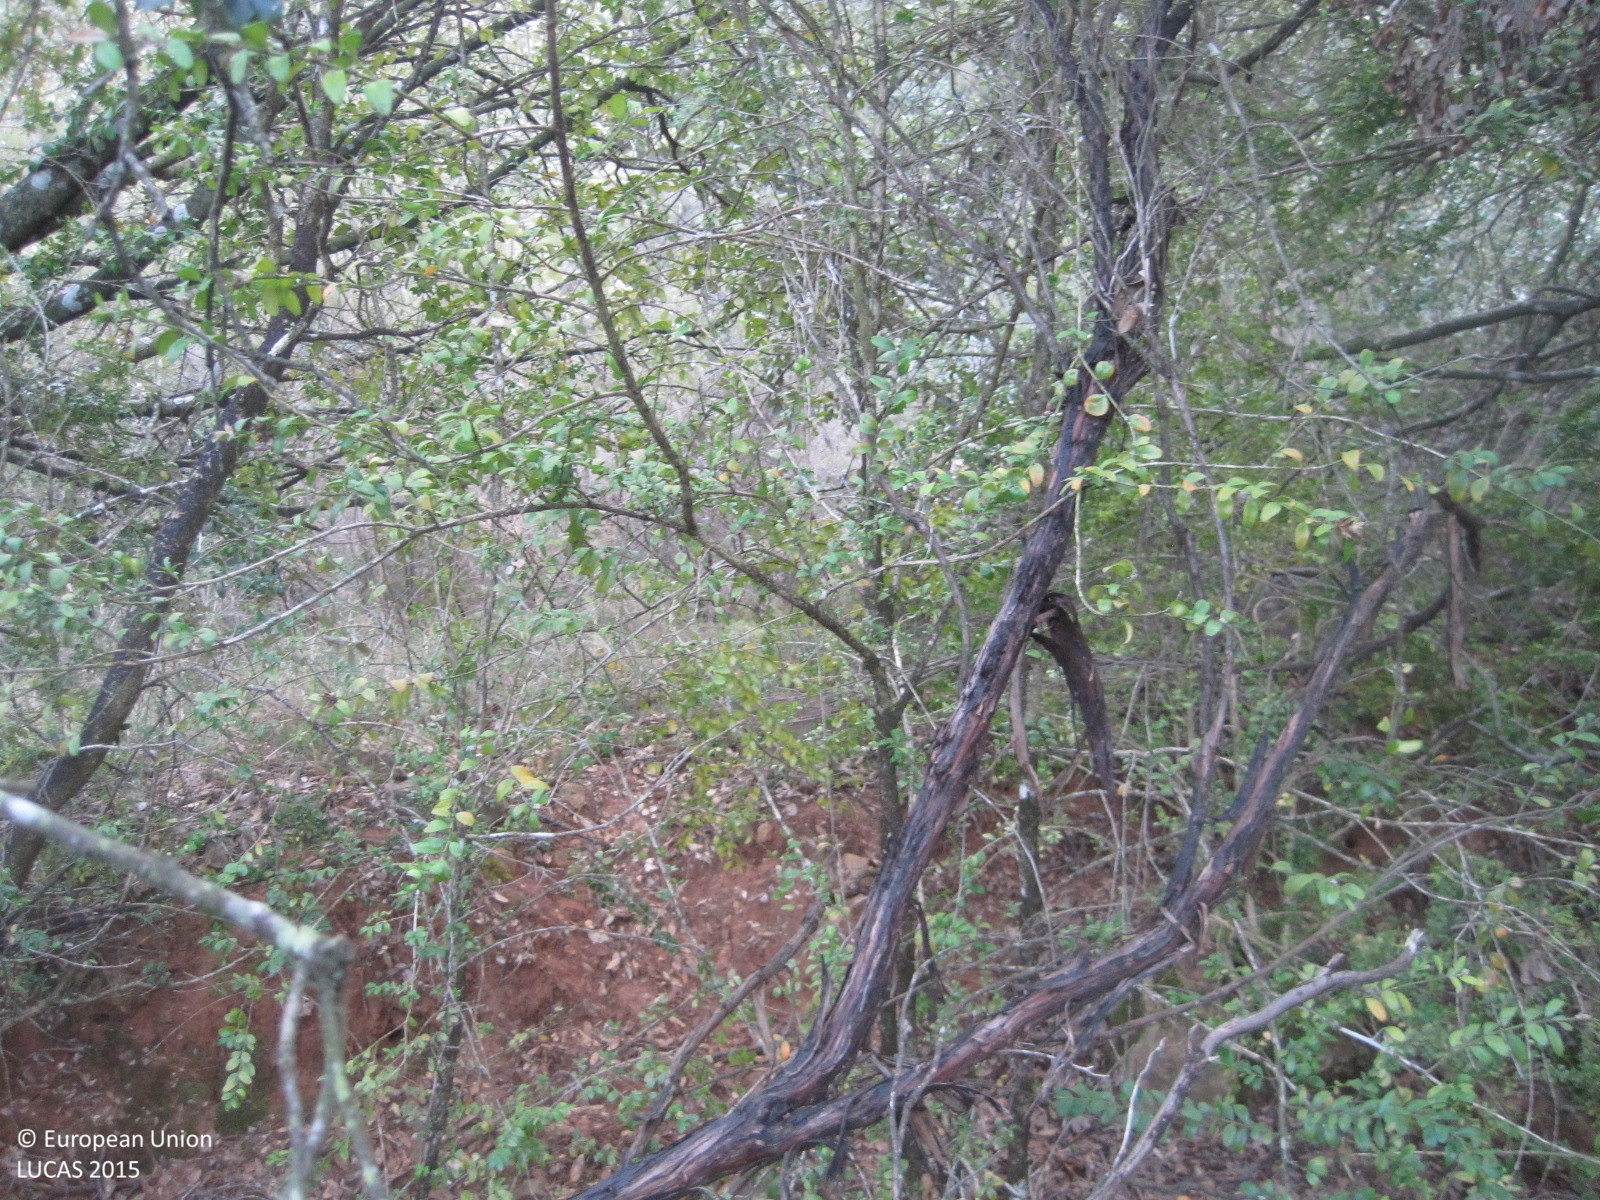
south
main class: Woodland
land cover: Broadleaved woodland
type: acidophilous oak and oak-birch forest
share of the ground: > 75 %
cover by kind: broadleaved forest trees 100 %
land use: Forestry
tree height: > 5 m
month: April
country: ES
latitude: 42.6577
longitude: -2.2311
